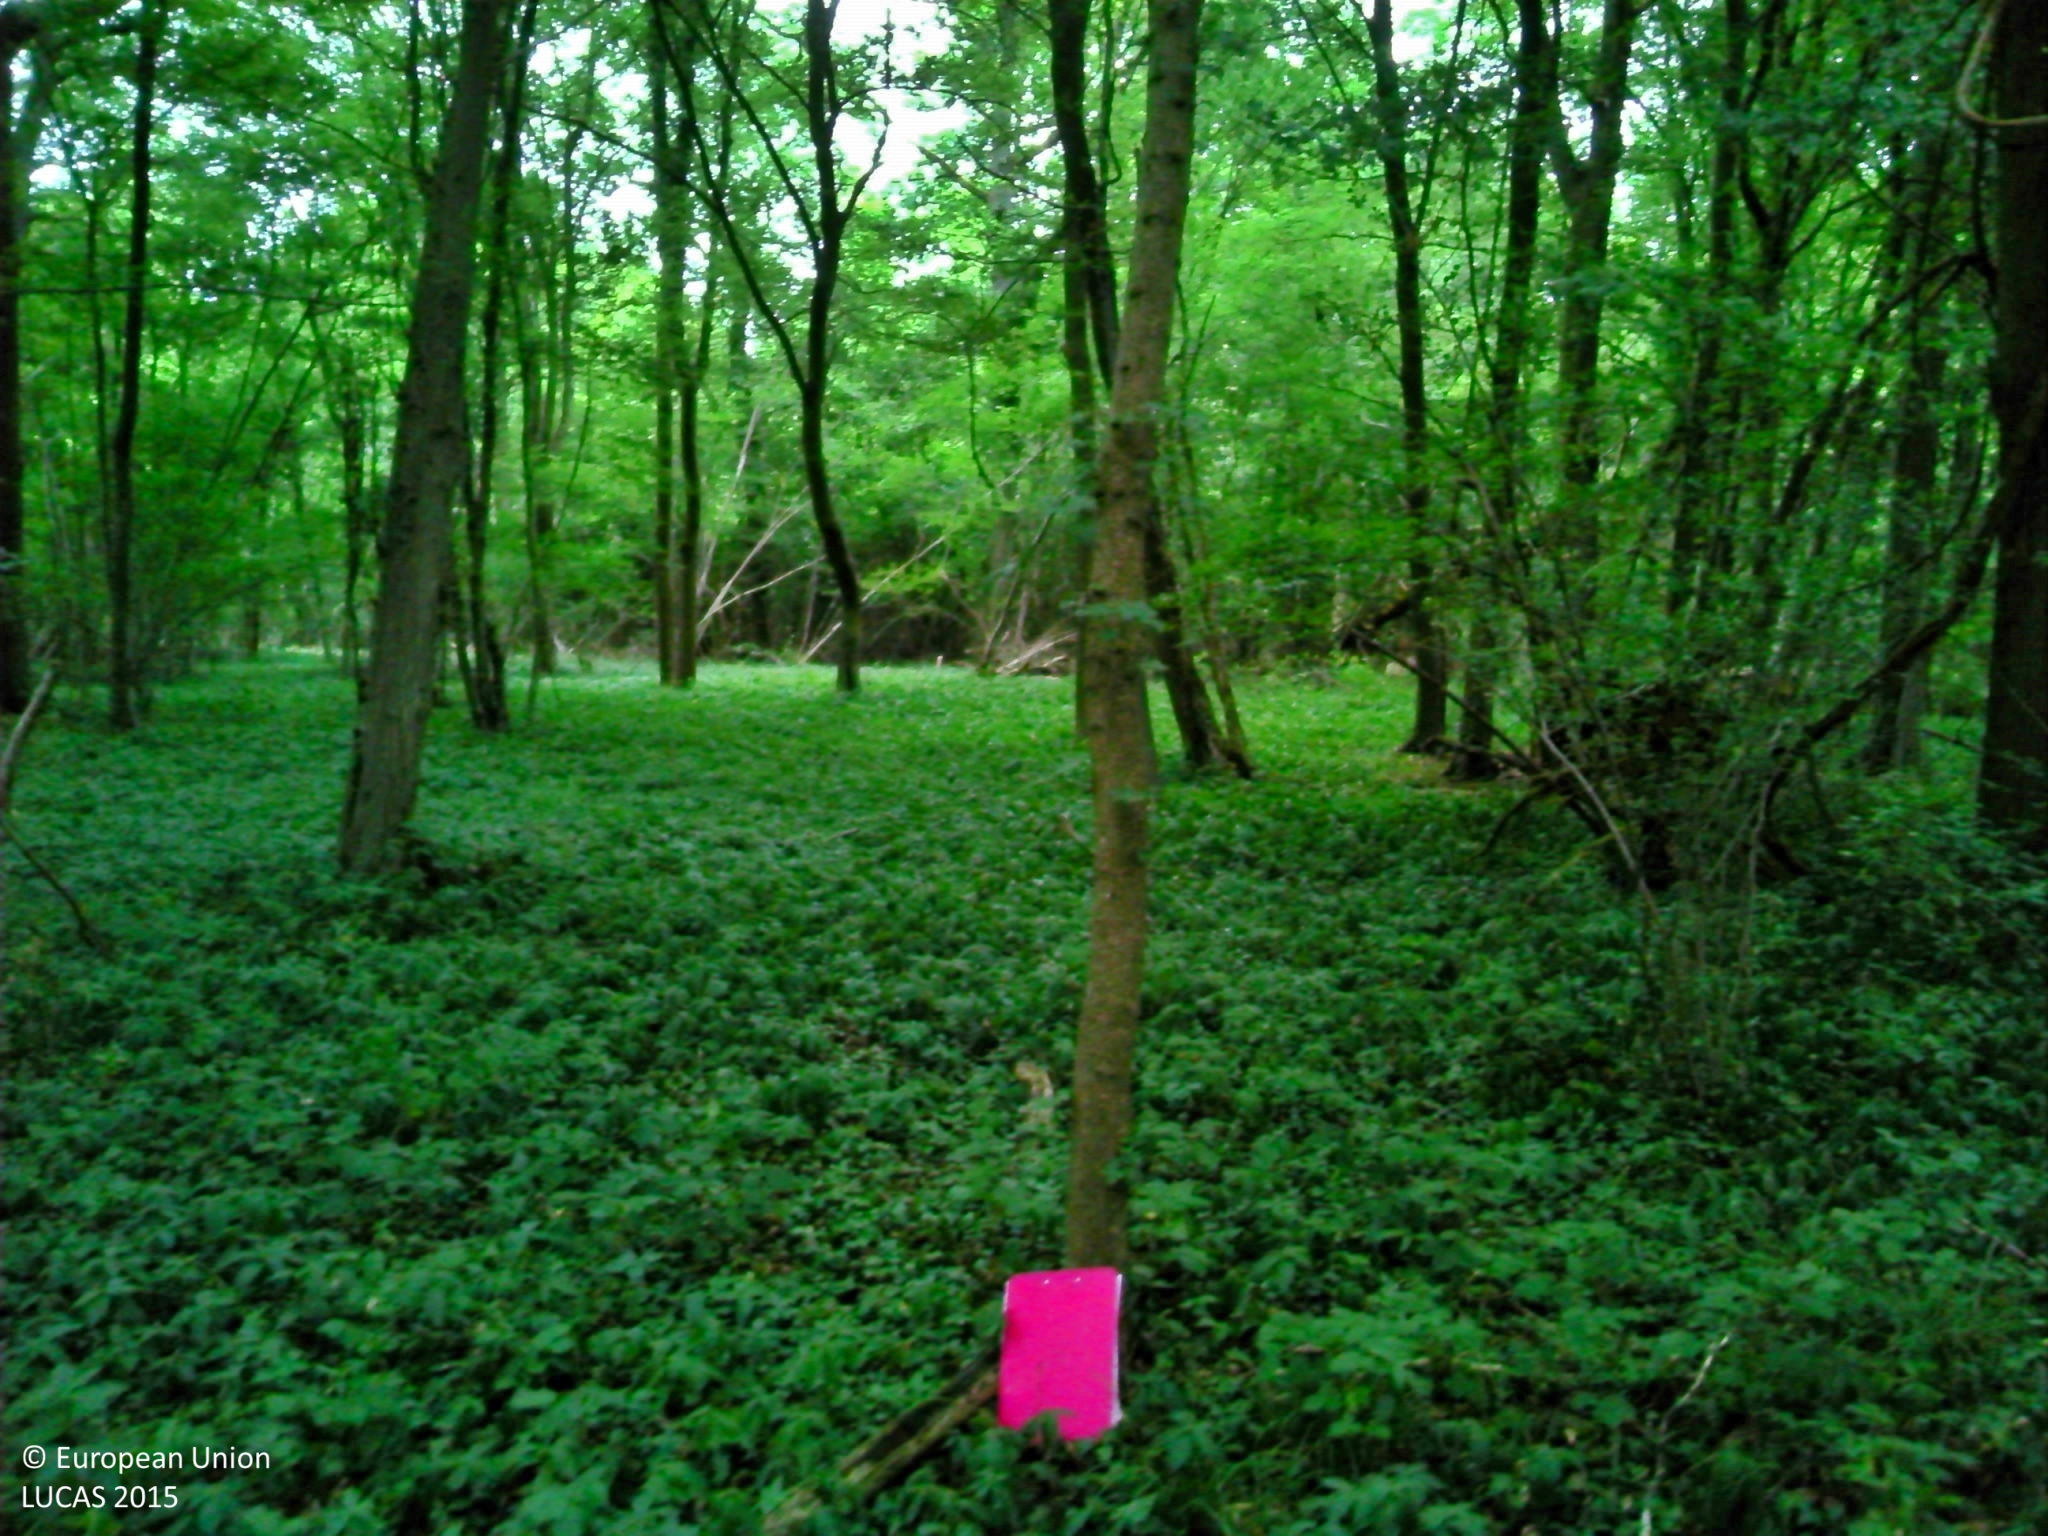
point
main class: Woodland
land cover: Broadleaved woodland
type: acidophilous oak and oak-birch forest
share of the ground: > 75 %
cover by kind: broadleaved forest trees 85 %, herbaceous plants 10 %, shrubs 5 %
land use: Forestry
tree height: > 5 m
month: July
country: FR
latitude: 49.3685
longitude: 2.3720
